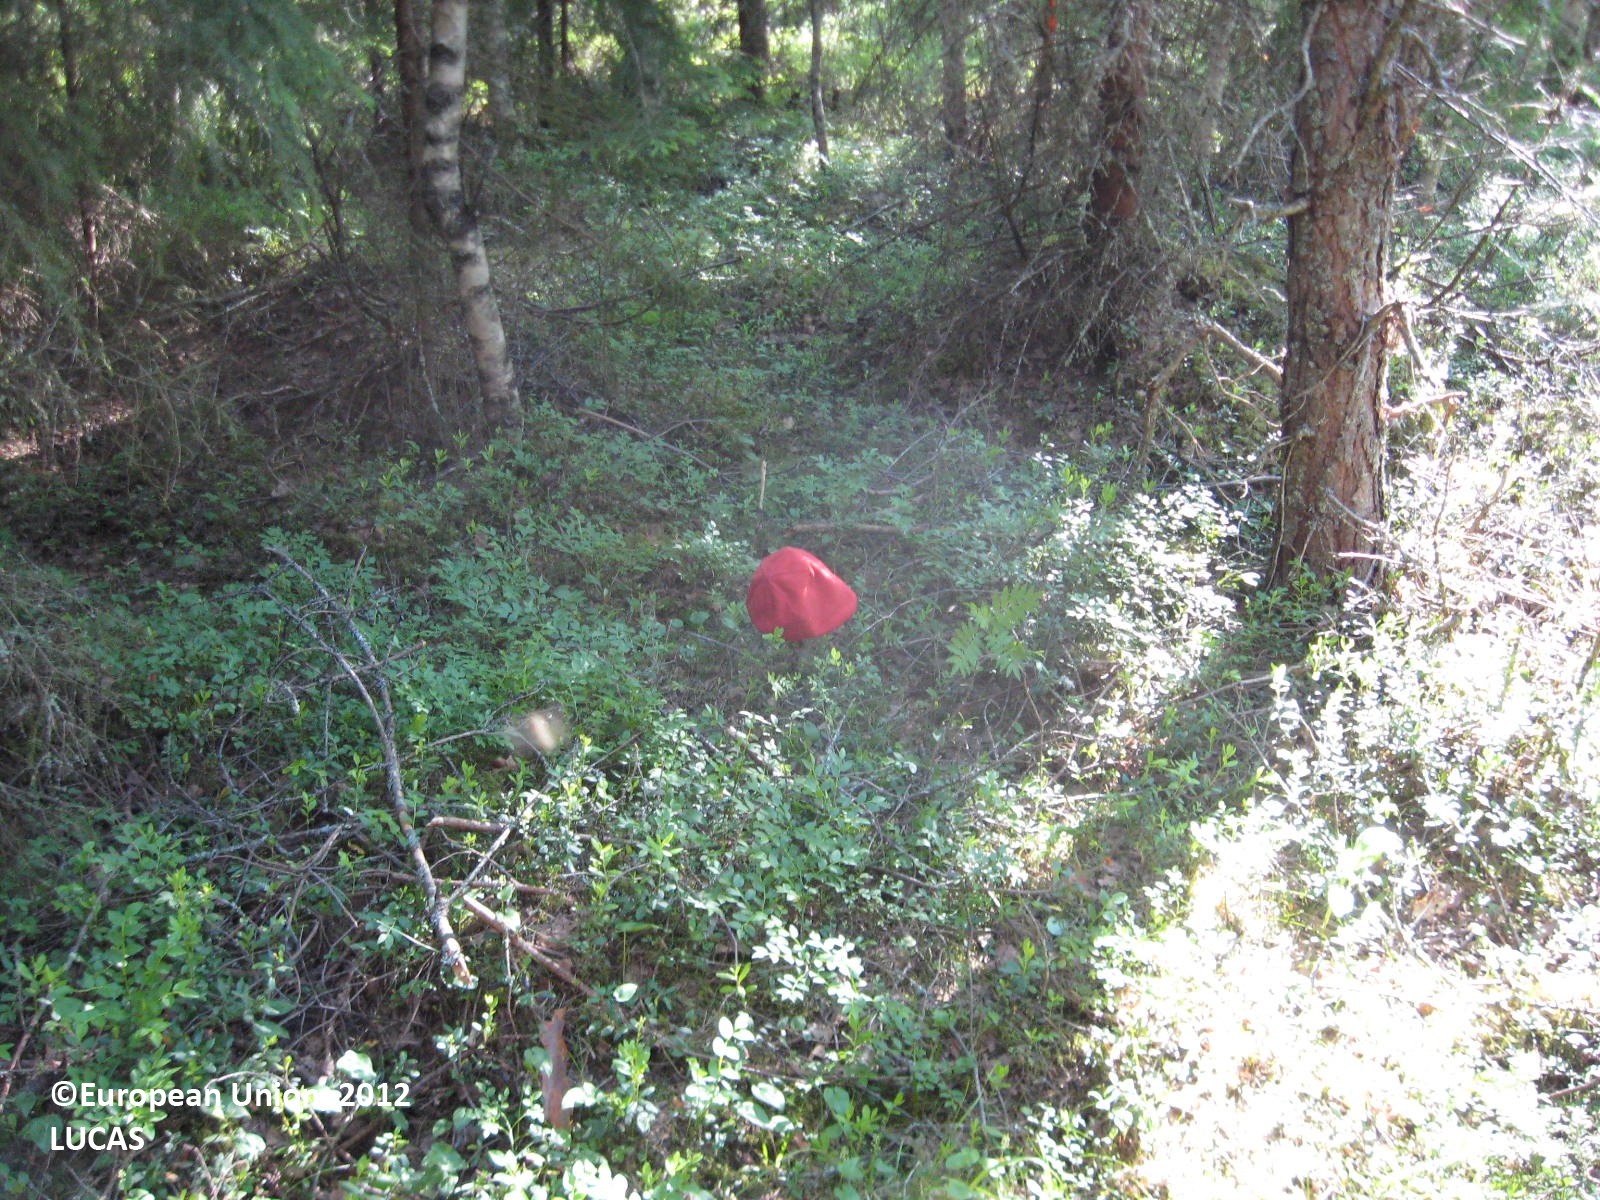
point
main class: Woodland
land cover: Spruce dominated mixed woodland
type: boreal forest
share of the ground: > 75 %
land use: Forestry
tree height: > 5 m
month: June
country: FI
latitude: 62.7490
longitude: 21.5724
